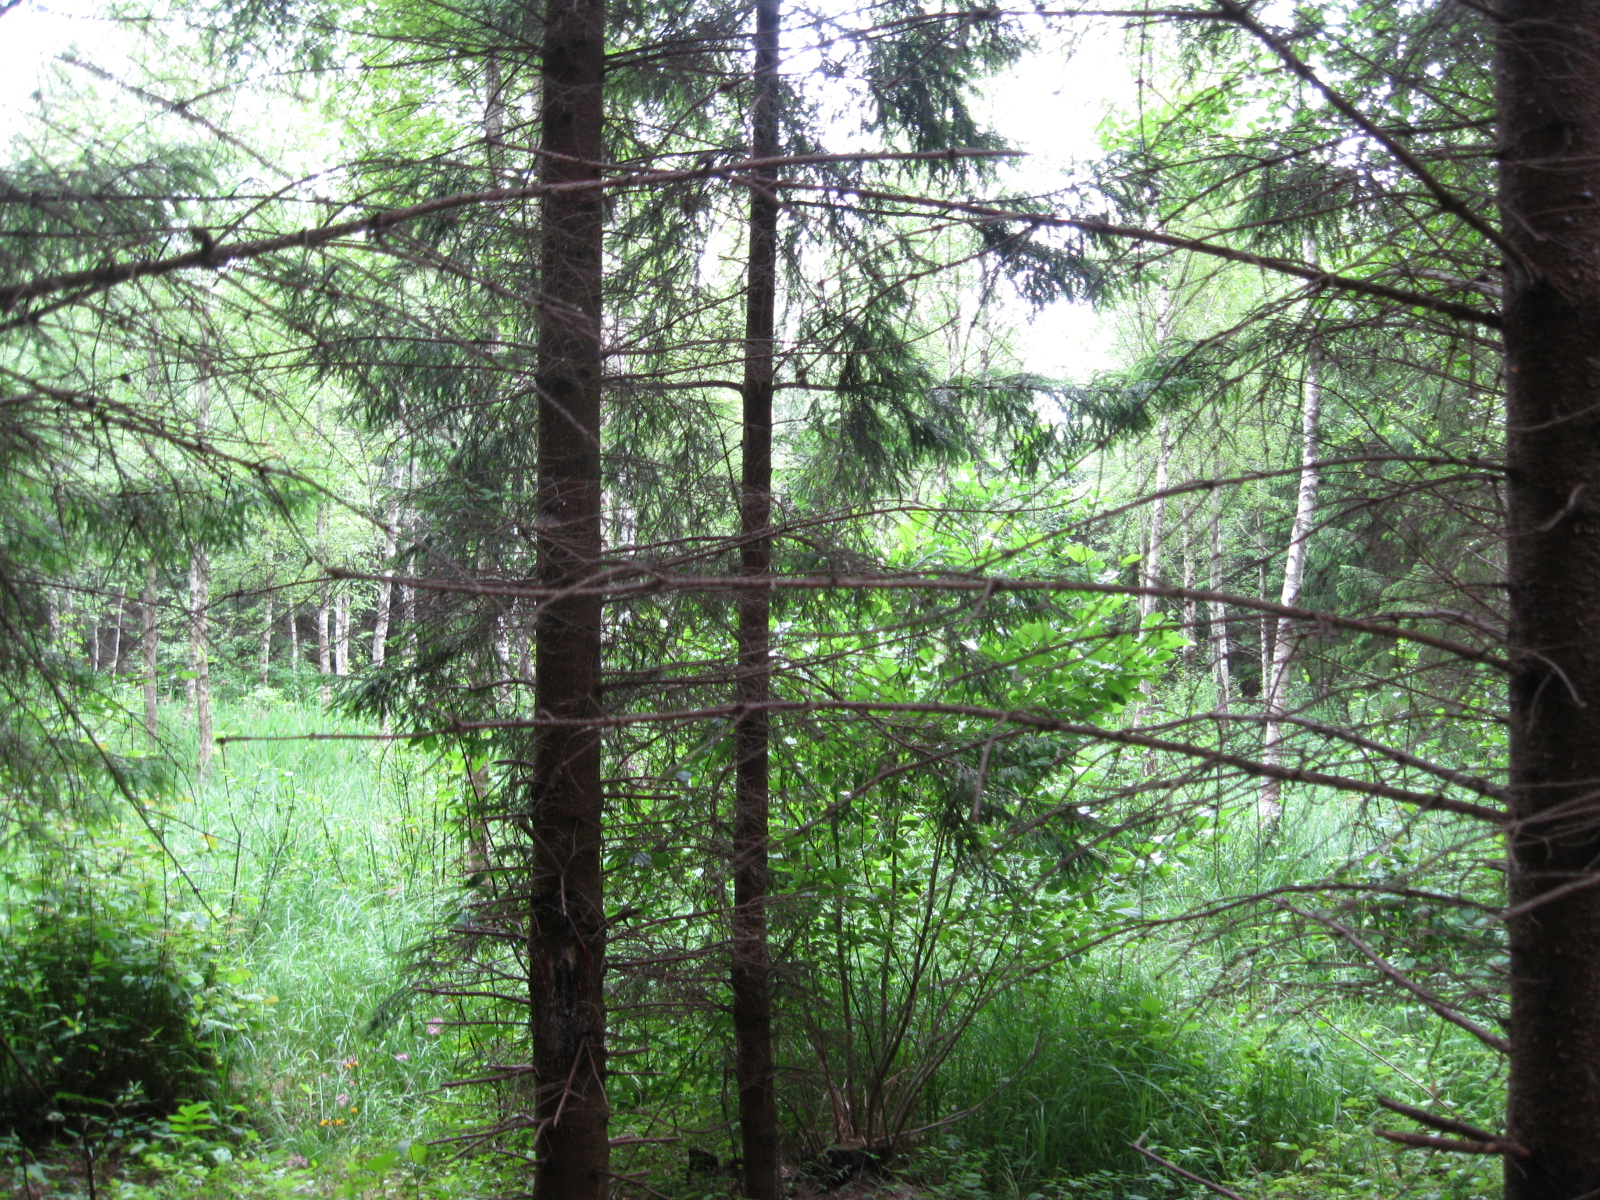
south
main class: Woodland
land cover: Spruce dominated coniferous woodland
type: hemiboreal forest and nemoral coniferous forest and mixed broadleaved-coniferous forest
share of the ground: > 75 %
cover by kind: coniferous forest trees 80 %, herbaceous plants 10 %, lichens and mosses 5 %, unconsolidated bare surface 5 %
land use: Forestry
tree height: > 5 m
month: June
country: LT
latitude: 55.4847
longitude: 24.1930
